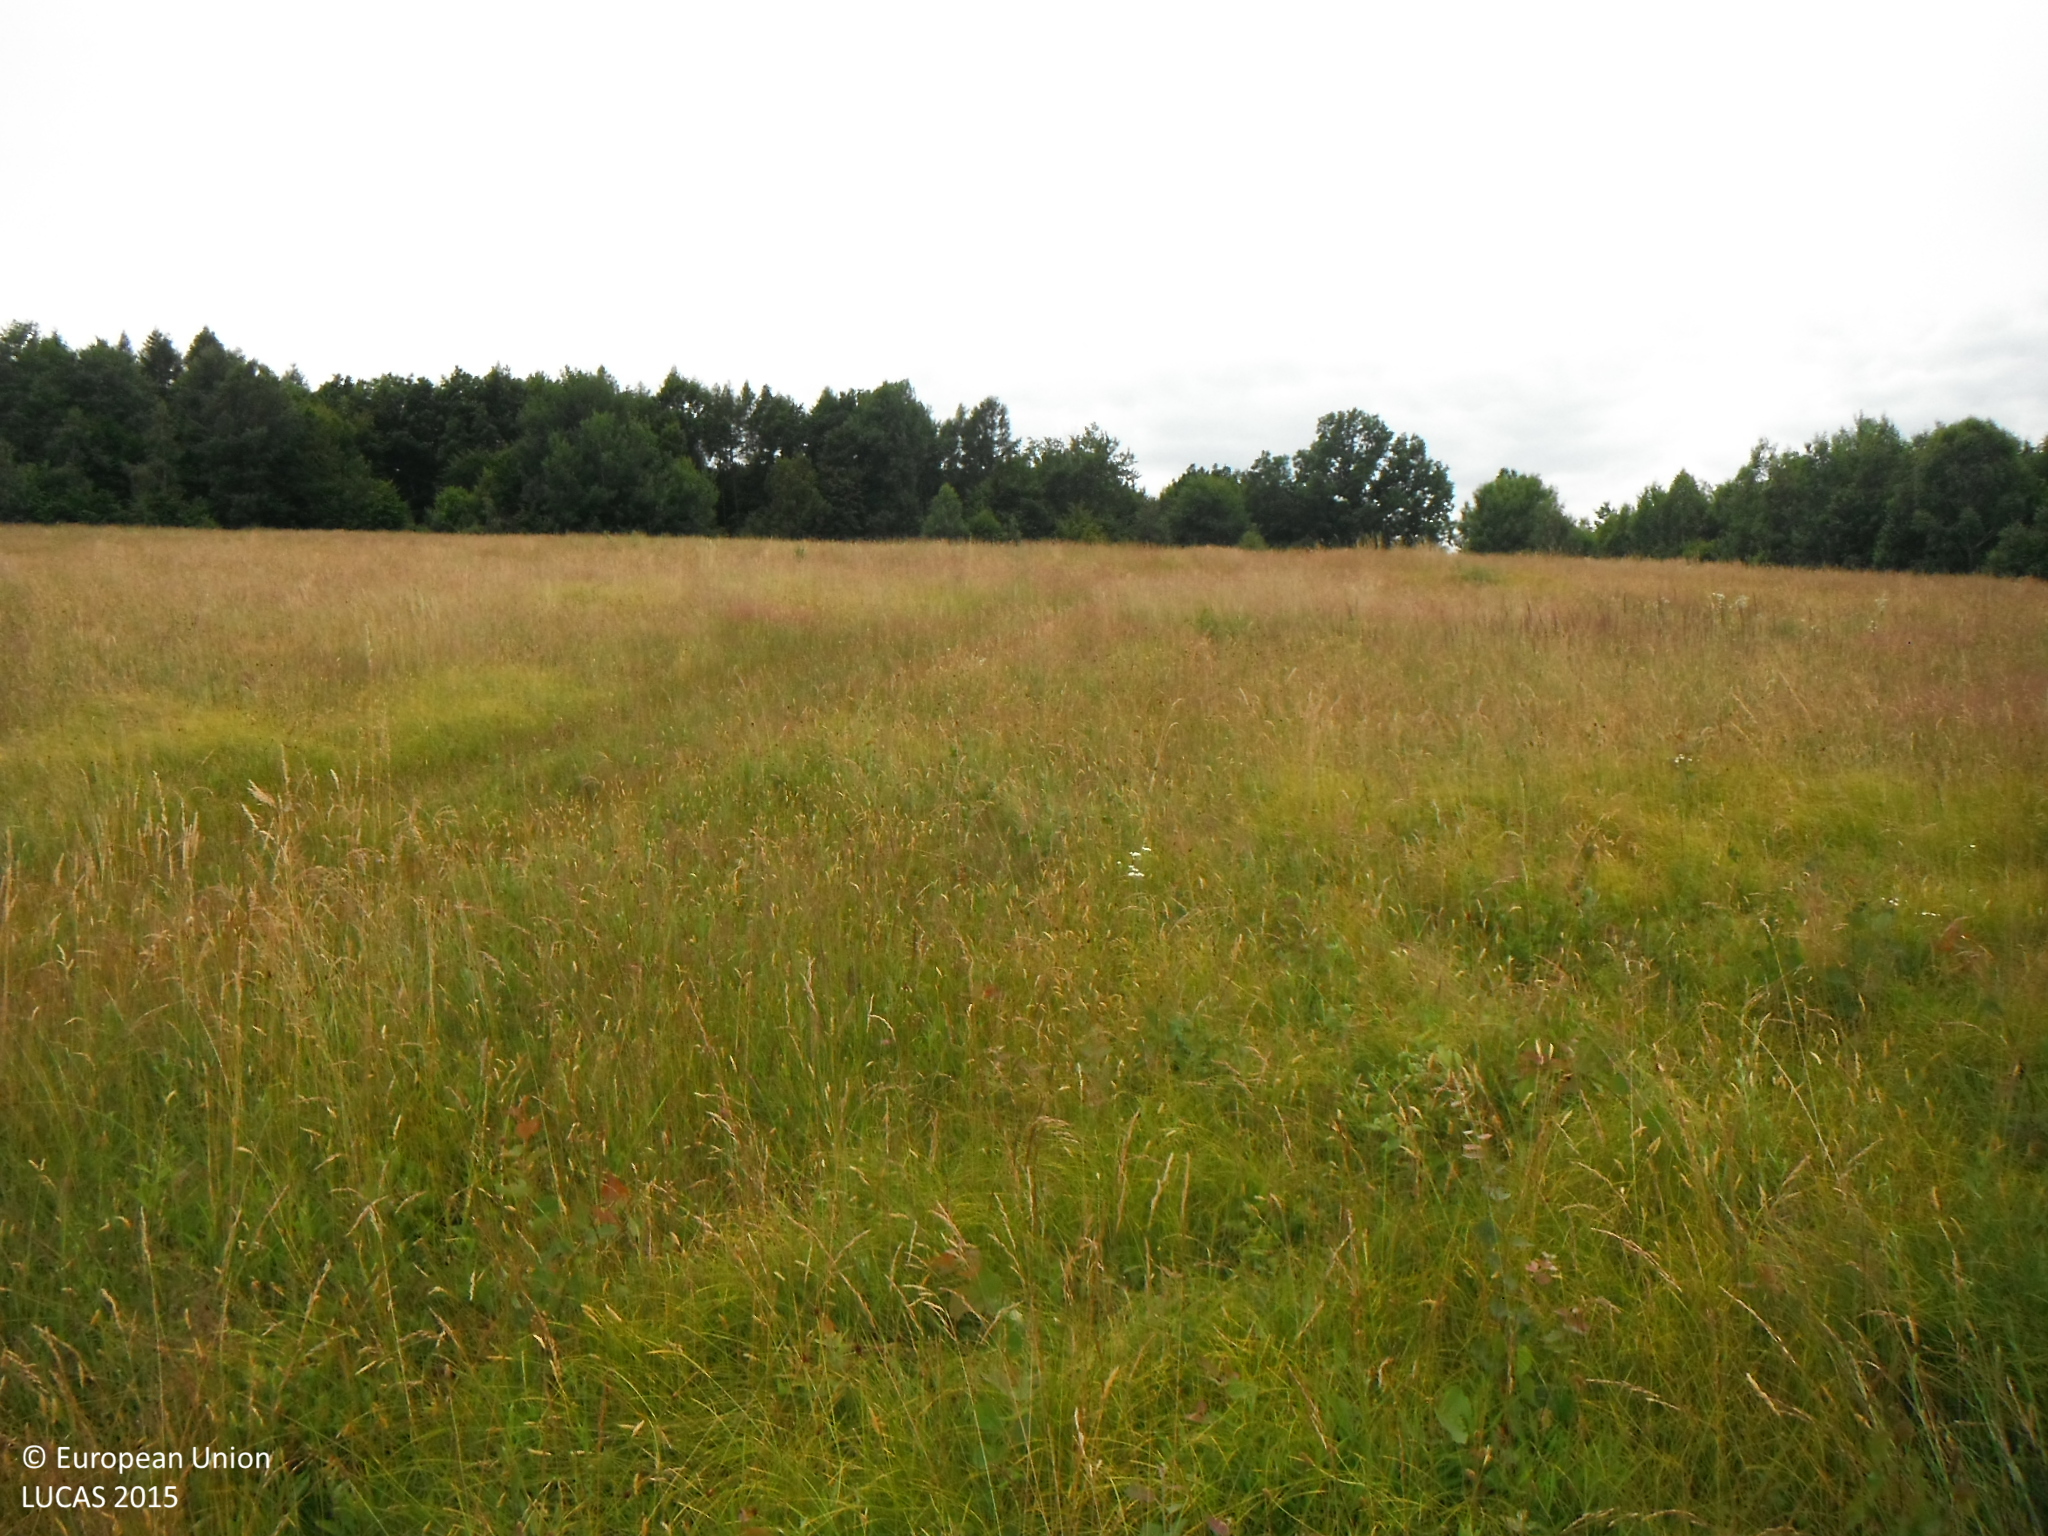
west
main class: Grassland
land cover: Grassland without tree/shrub cover
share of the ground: > 75 %
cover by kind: herbaceous plants 100 %
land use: Agriculture (excluding fallow land and kitchen gardens)
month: June
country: SK
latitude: 49.0034
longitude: 21.9891
